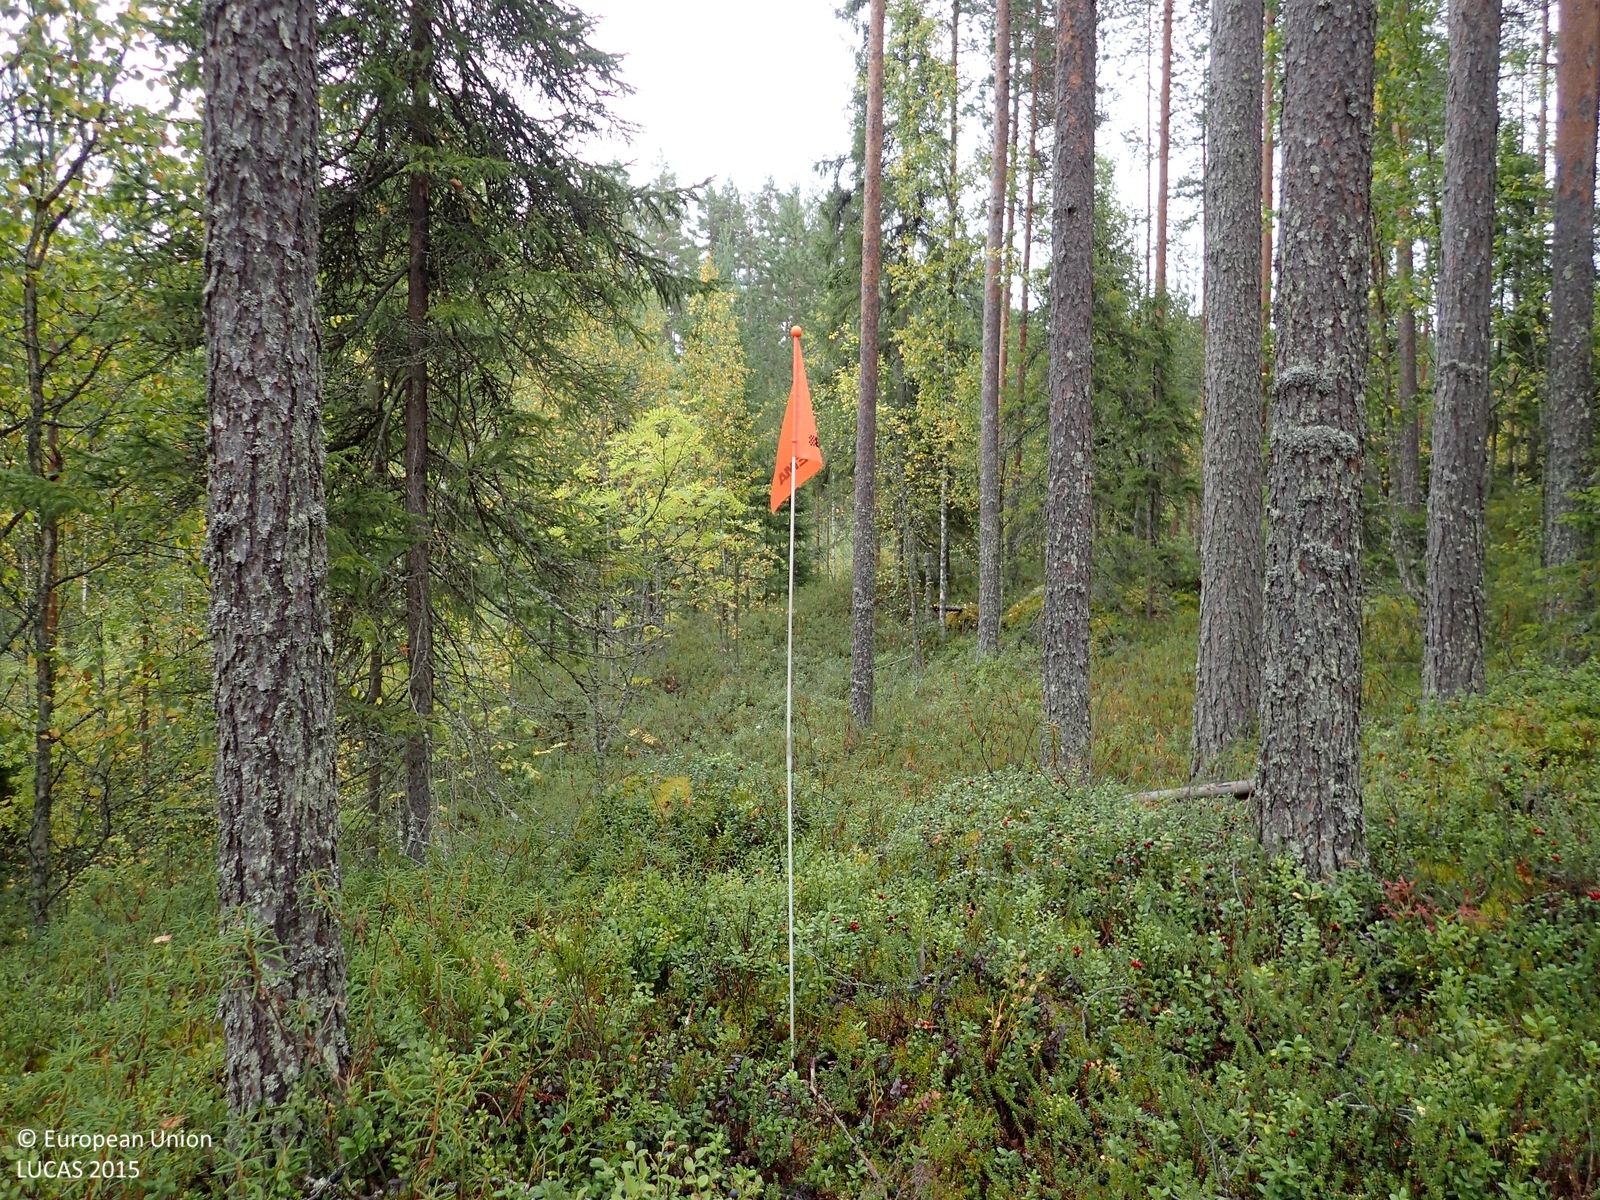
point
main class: Woodland
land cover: Pine dominated mixed woodland
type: boreal forest
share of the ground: 50 - 75 %
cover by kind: coniferous forest trees 45 %, shrubs 35 %, broadleaved forest trees 15 %, lichens and mosses 5 %
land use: Forestry
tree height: > 5 m
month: September
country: FI
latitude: 63.1122
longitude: 26.0339
